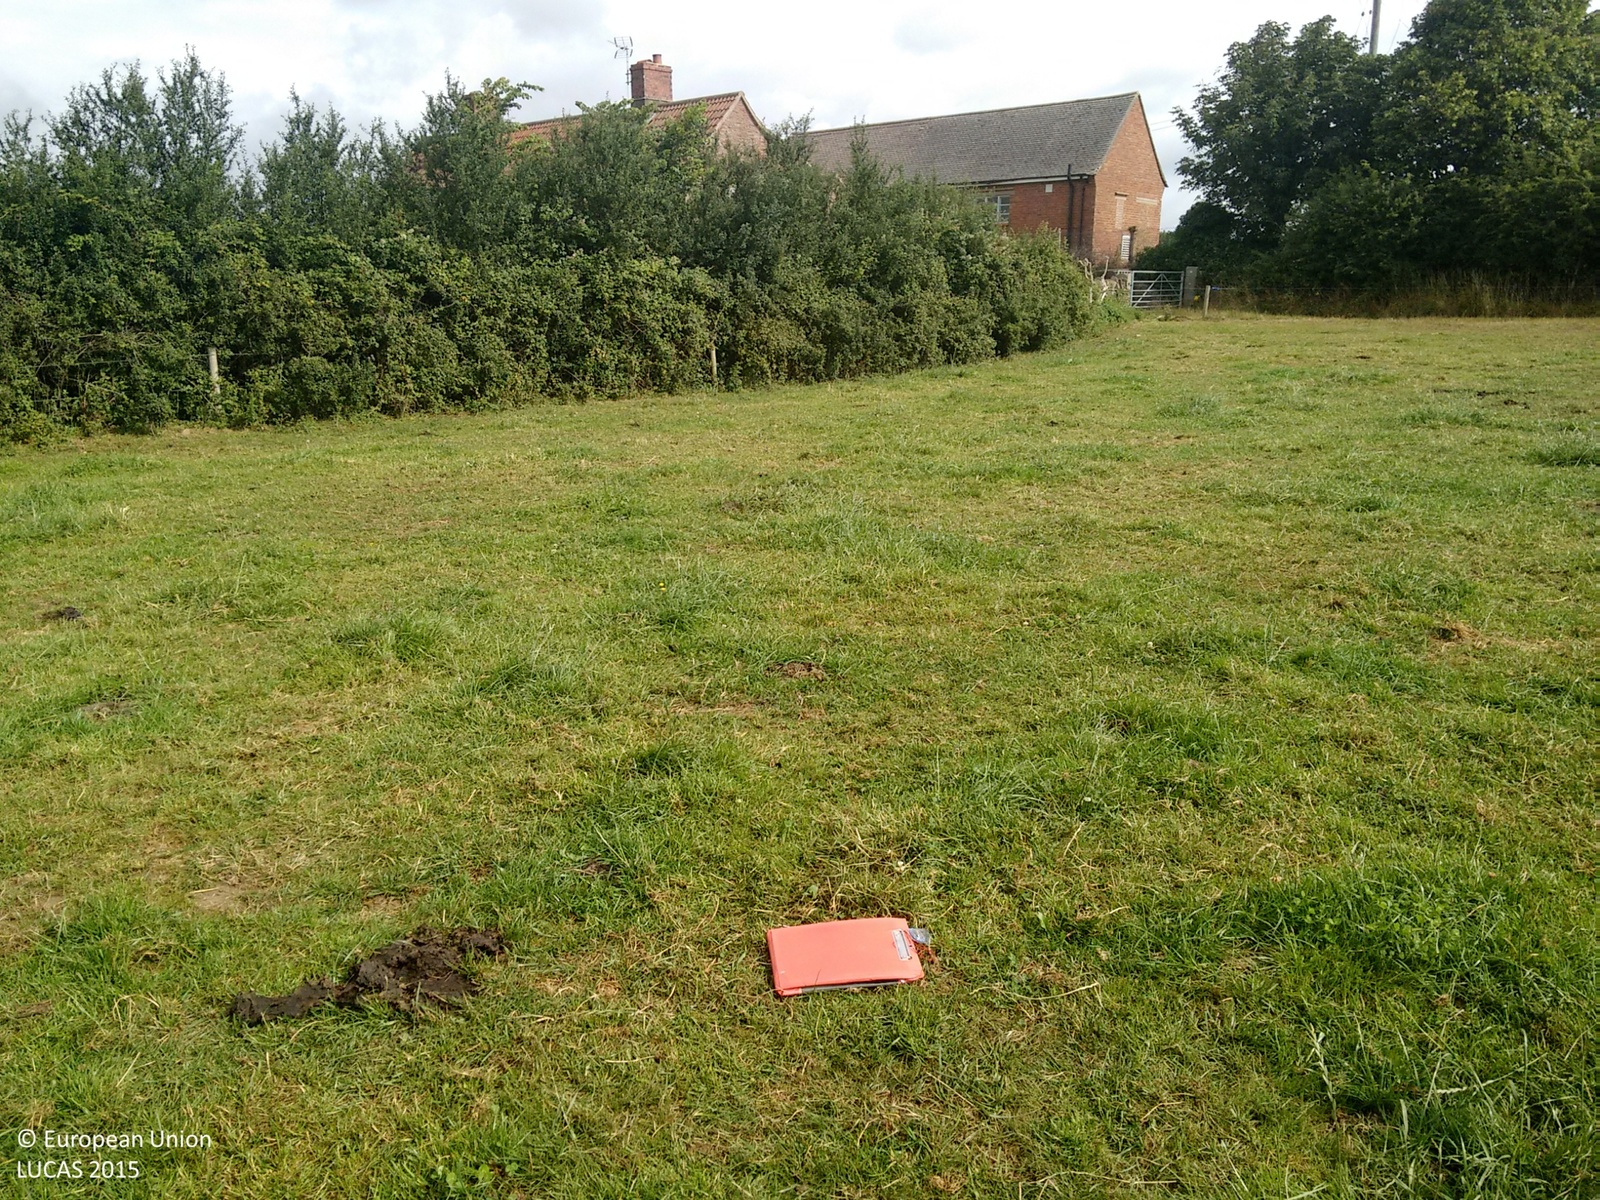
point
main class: Grassland
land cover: Grassland without tree/shrub cover
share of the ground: > 75 %
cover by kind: herbaceous plants 100 %
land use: Agriculture (excluding fallow land and kitchen gardens)
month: July
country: GB
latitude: 51.5545
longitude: -2.4549
